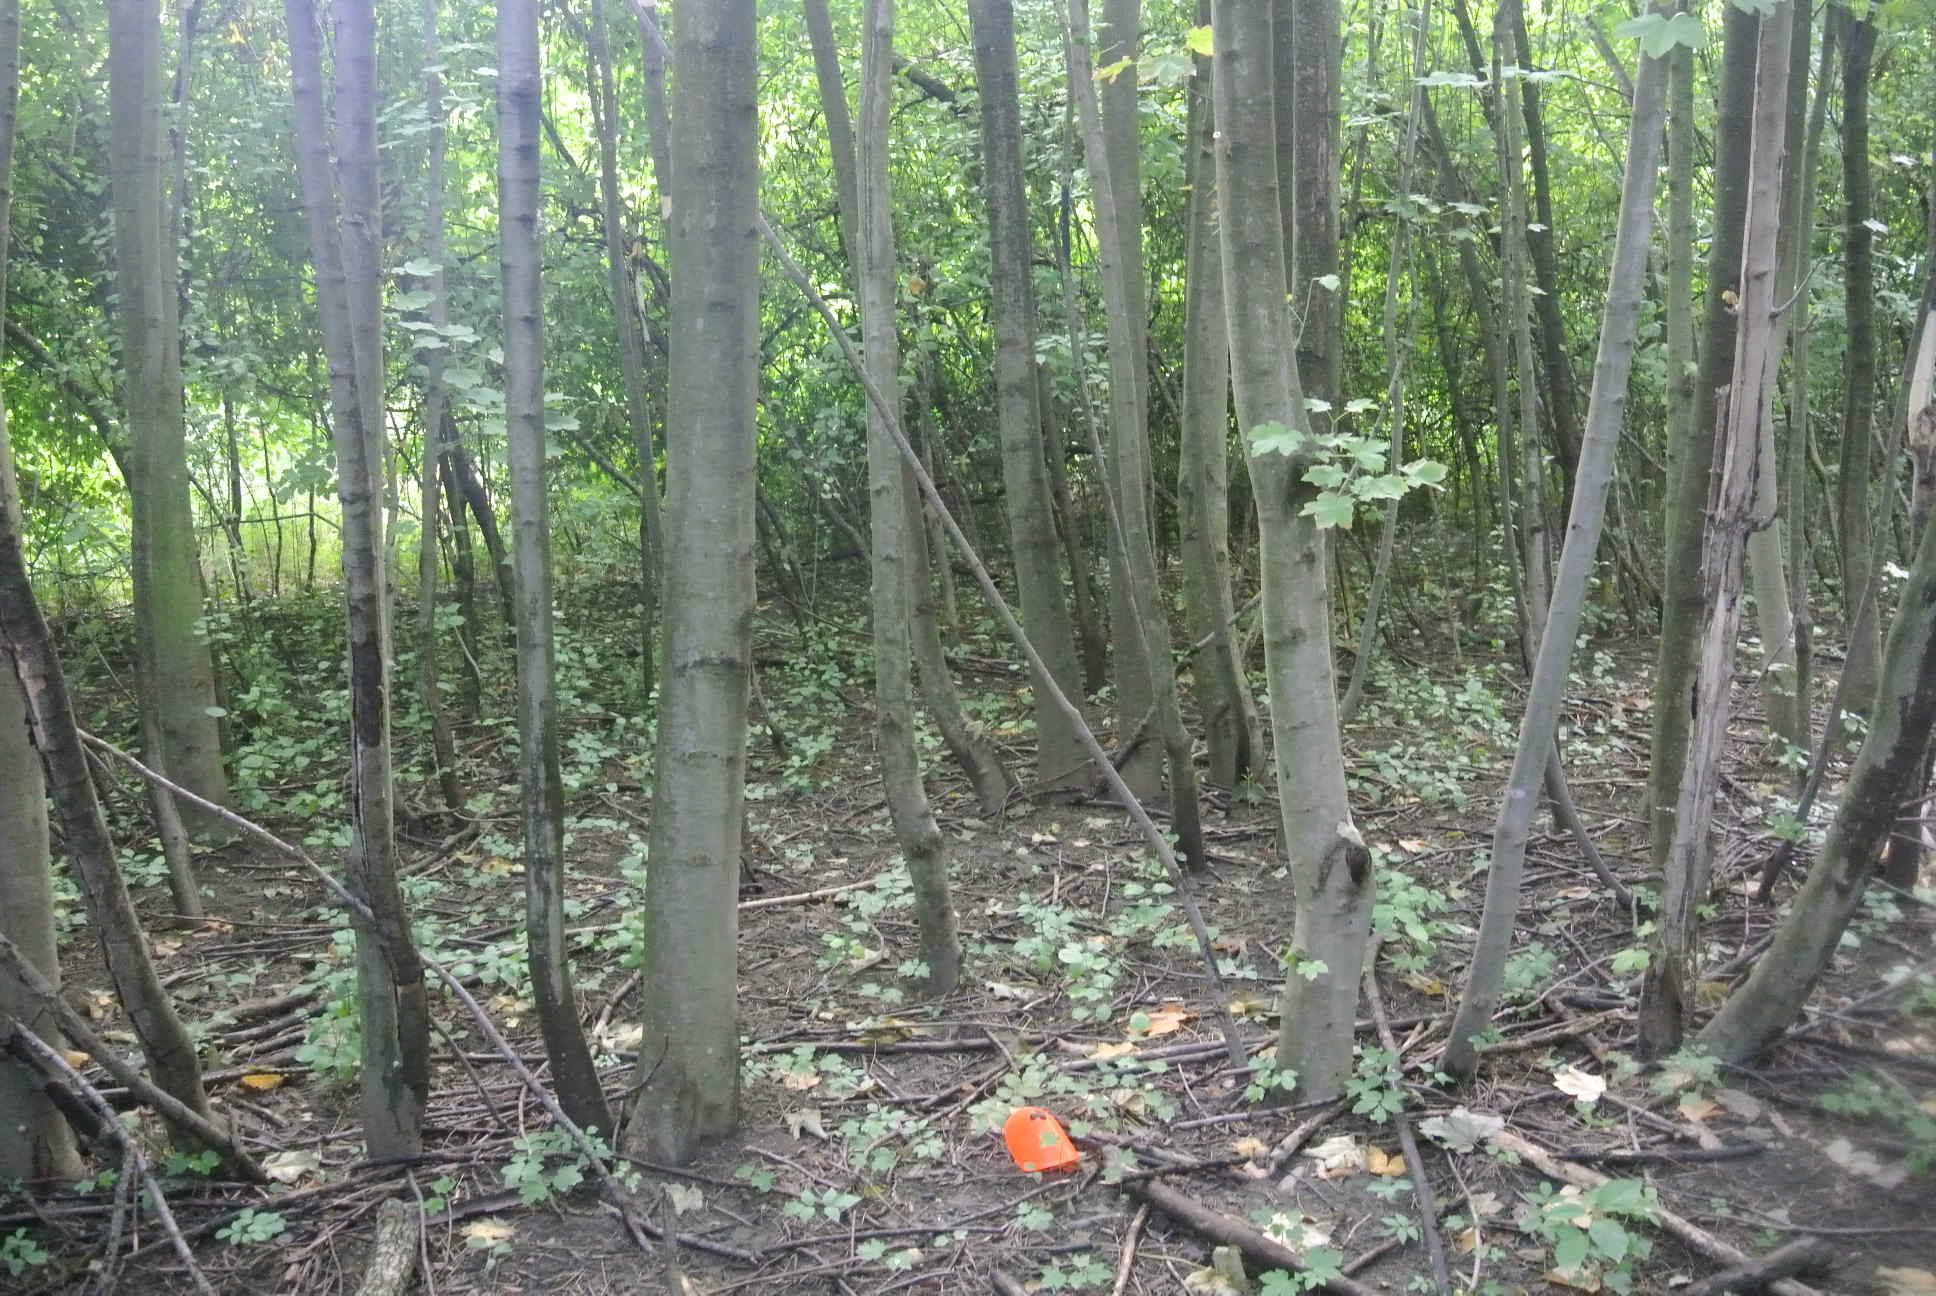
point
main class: Woodland
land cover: Broadleaved woodland
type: mesophytic deciduous forest
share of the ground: > 75 %
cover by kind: broadleaved forest trees 100 %
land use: Forestry
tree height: > 5 m
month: July
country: AT
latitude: 48.0296
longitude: 16.8322
